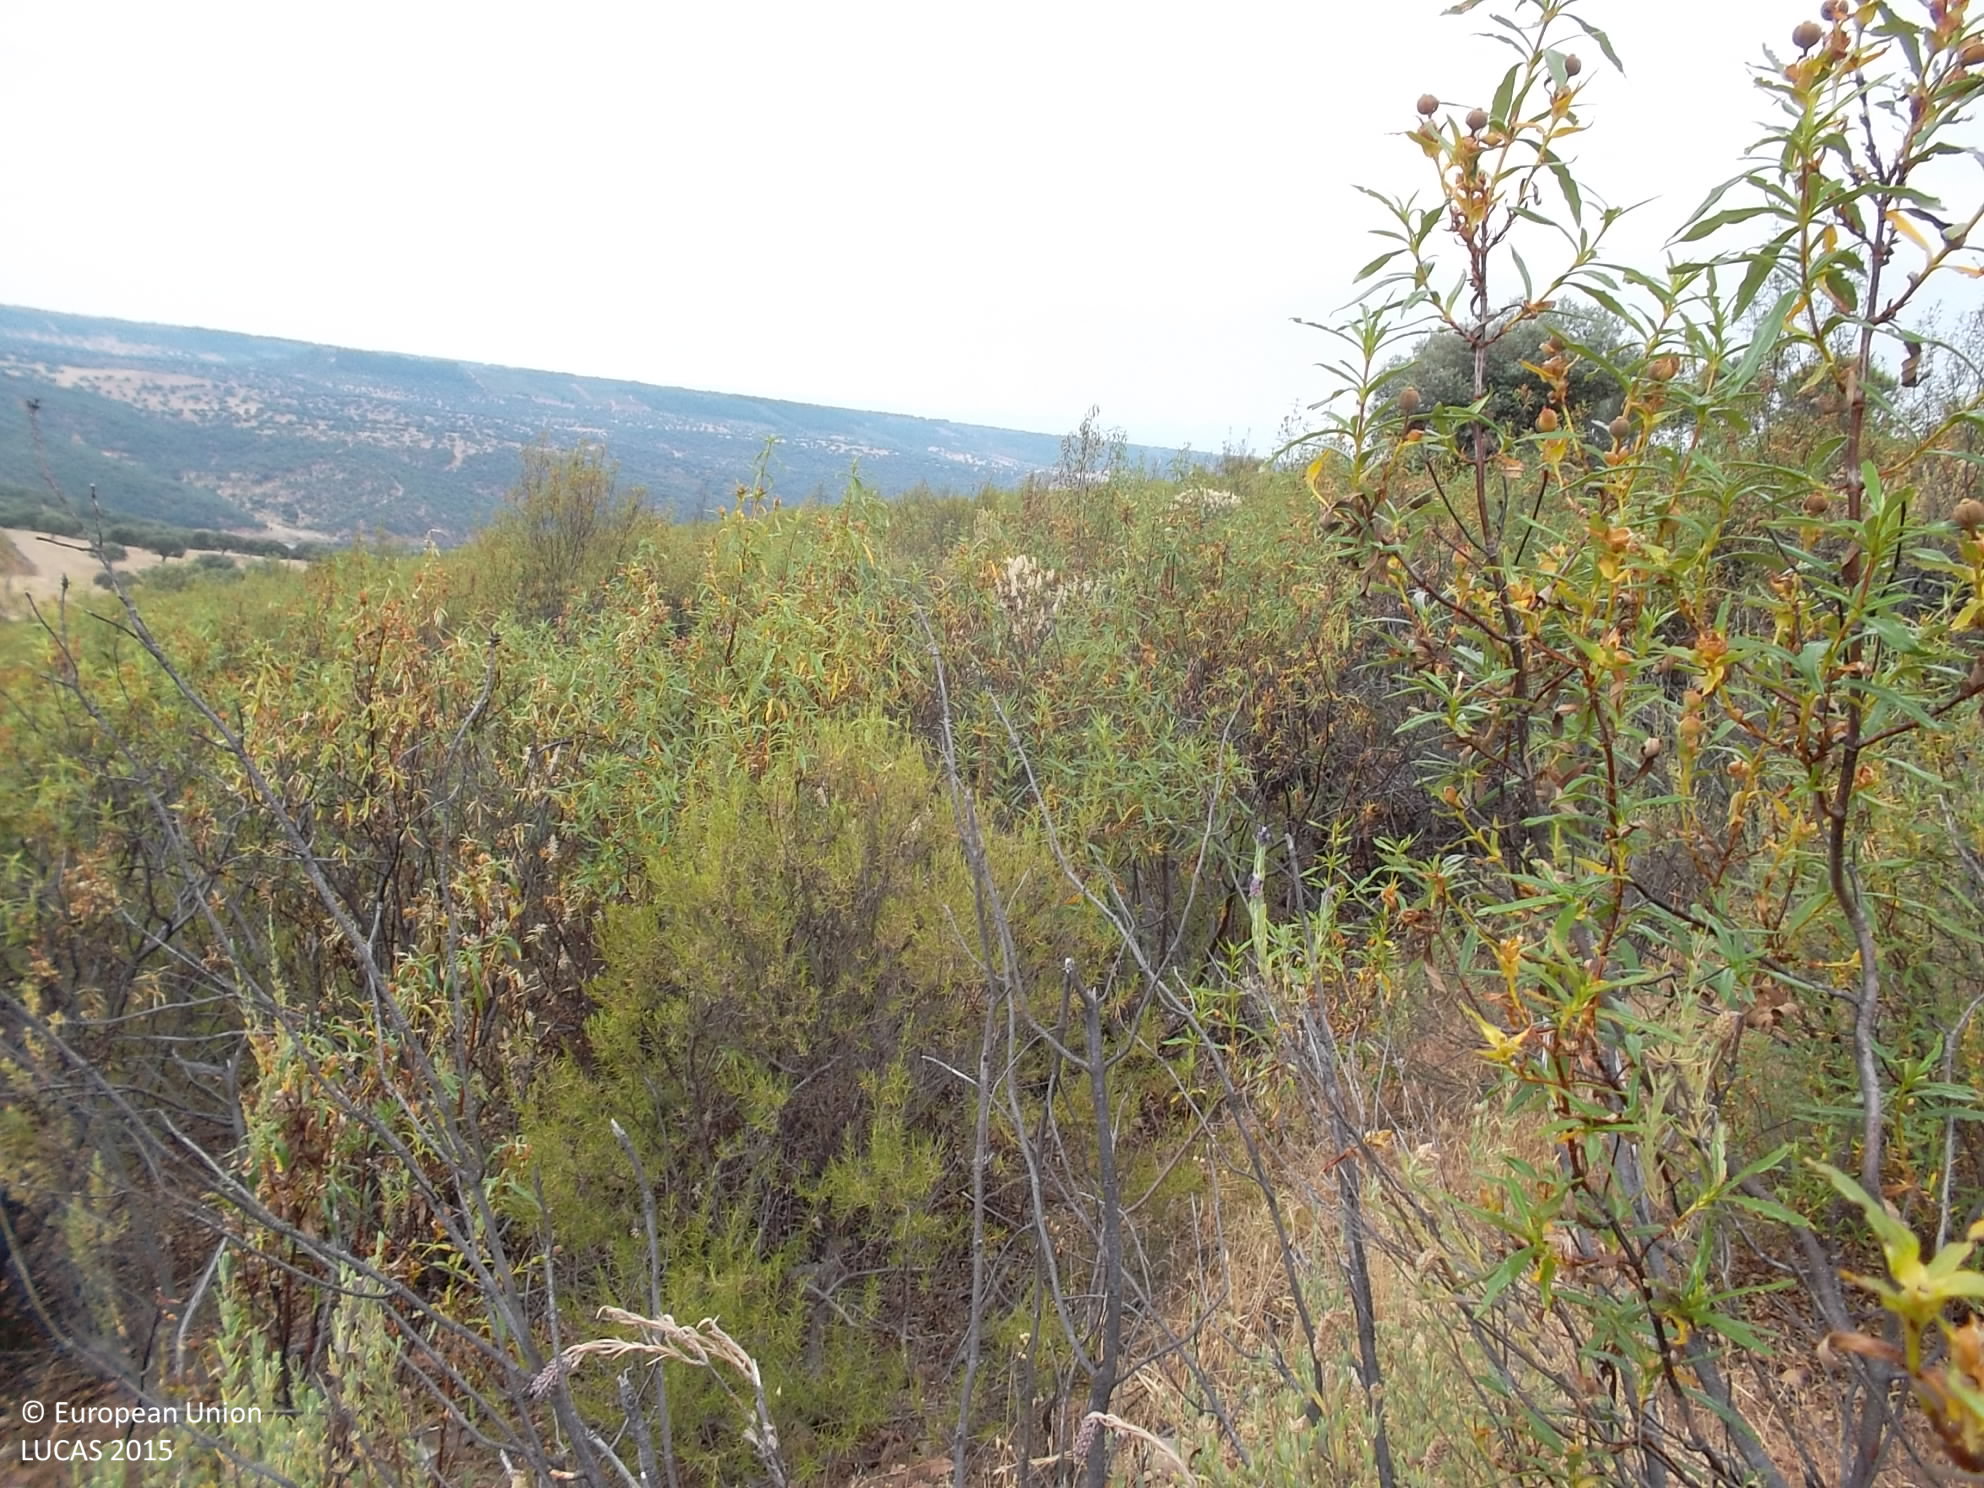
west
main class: Woodland
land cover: Broadleaved woodland
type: broadleaved evergreen forest
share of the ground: 50 - 75 %
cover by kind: shrubs 70 %, broadleaved forest trees 20 %, herbaceous plants 10 %
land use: Semi-natural and natural areas not in use
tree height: > 5 m
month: June
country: ES
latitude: 39.3459
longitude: -4.9979
